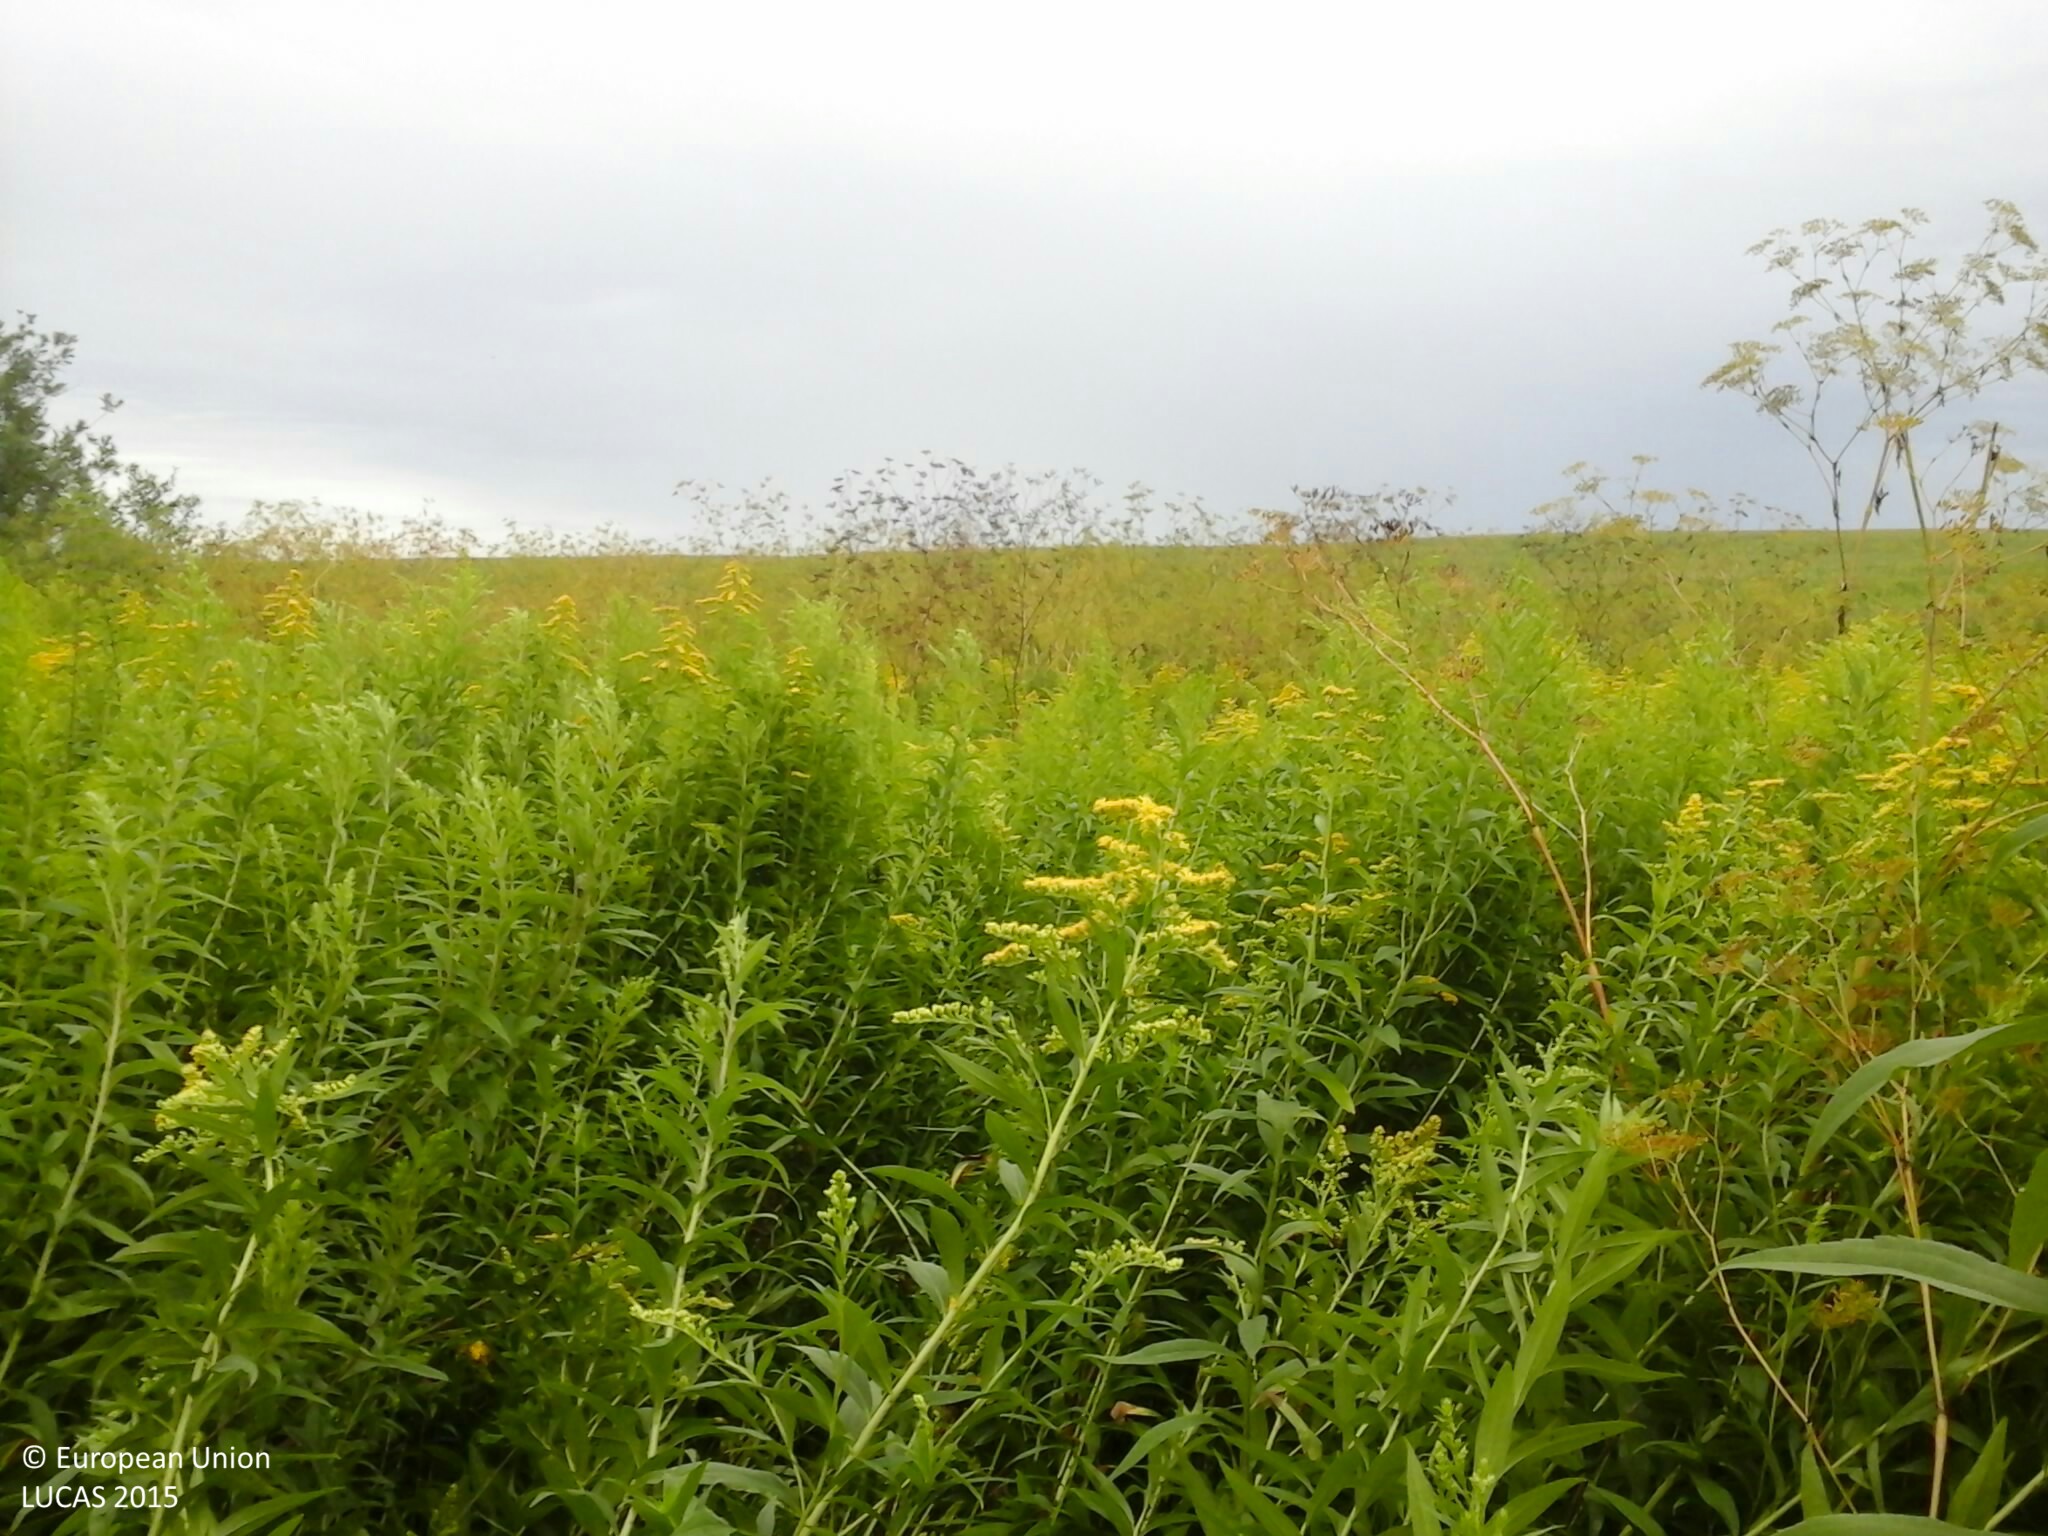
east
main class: Grassland
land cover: Spontaneously vegetated surfaces
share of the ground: > 75 %
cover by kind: herbaceous plants 100 %
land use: Semi-natural and natural areas not in use
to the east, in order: Spontaneously vegetated surfaces; Ditches and canals; Common wheat; Maize
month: July
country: HU
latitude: 46.5607
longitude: 17.7156
